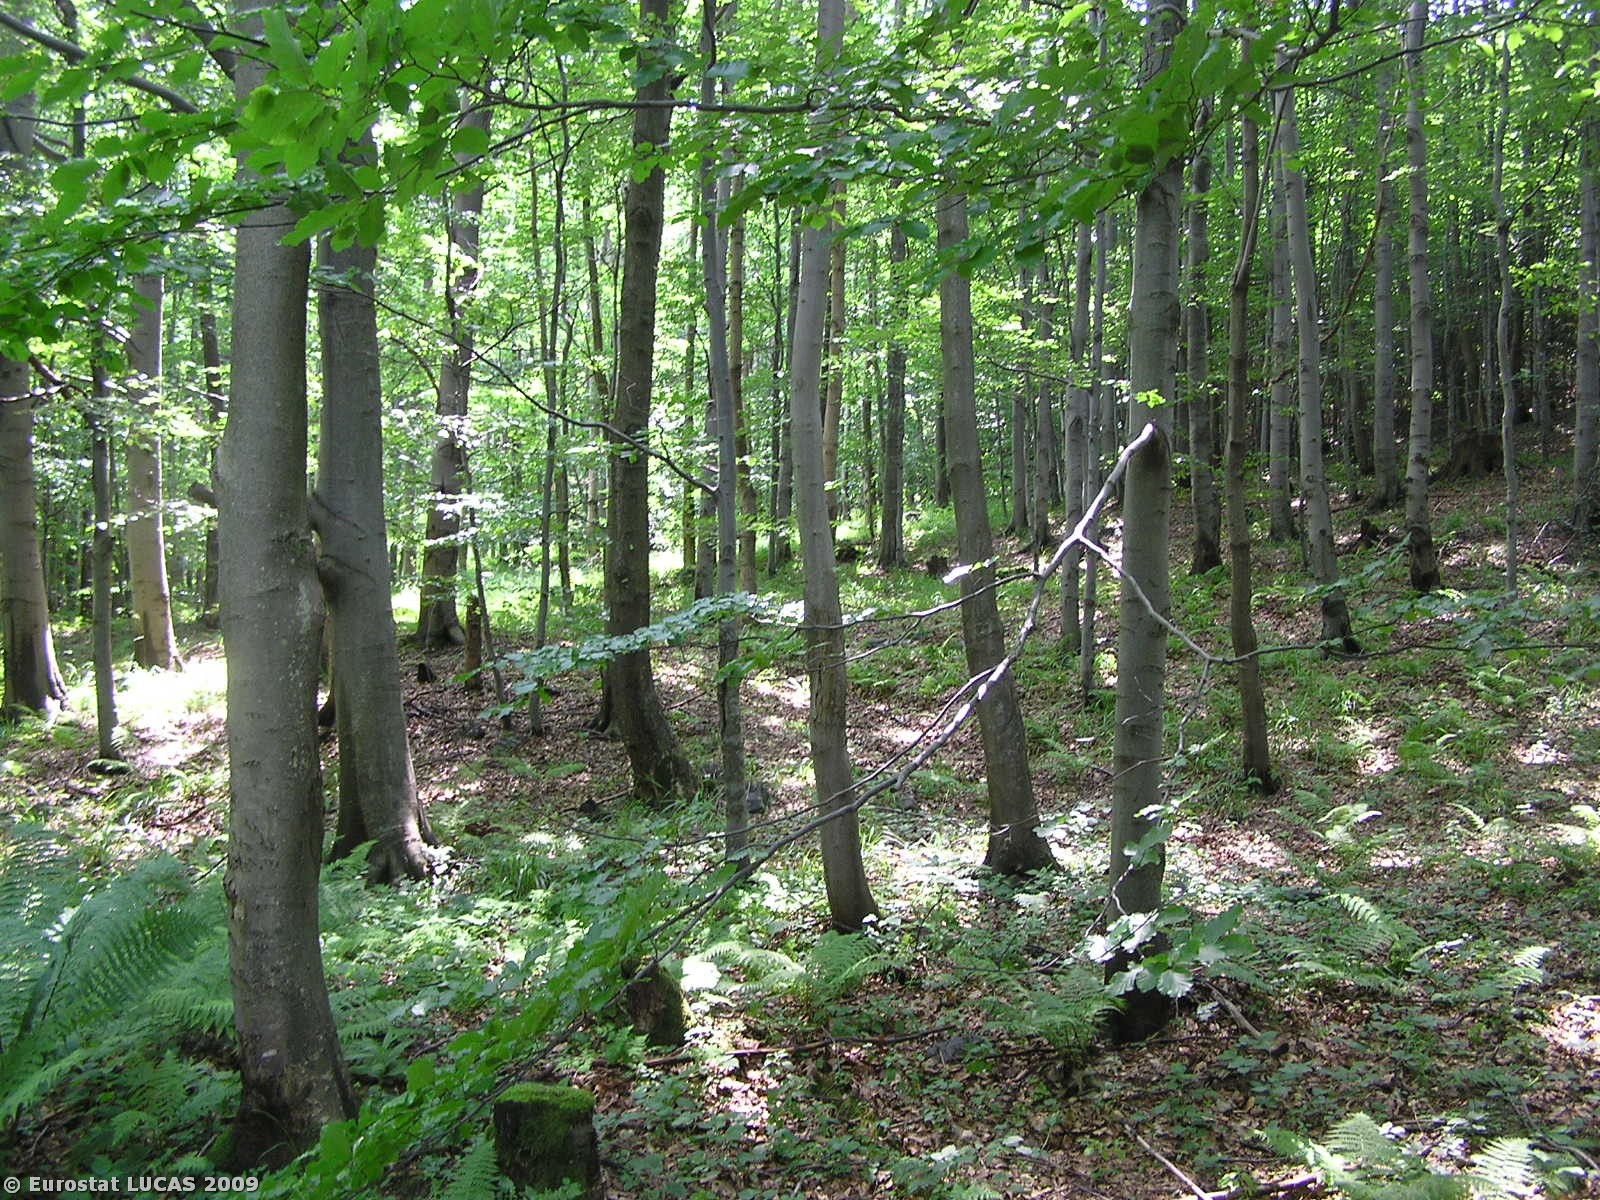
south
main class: Woodland
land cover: Broadleaved woodland
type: beech forest
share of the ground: > 75 %
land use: Forestry
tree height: > 5 m
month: July
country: CZ
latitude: 50.2415
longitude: 17.2604
